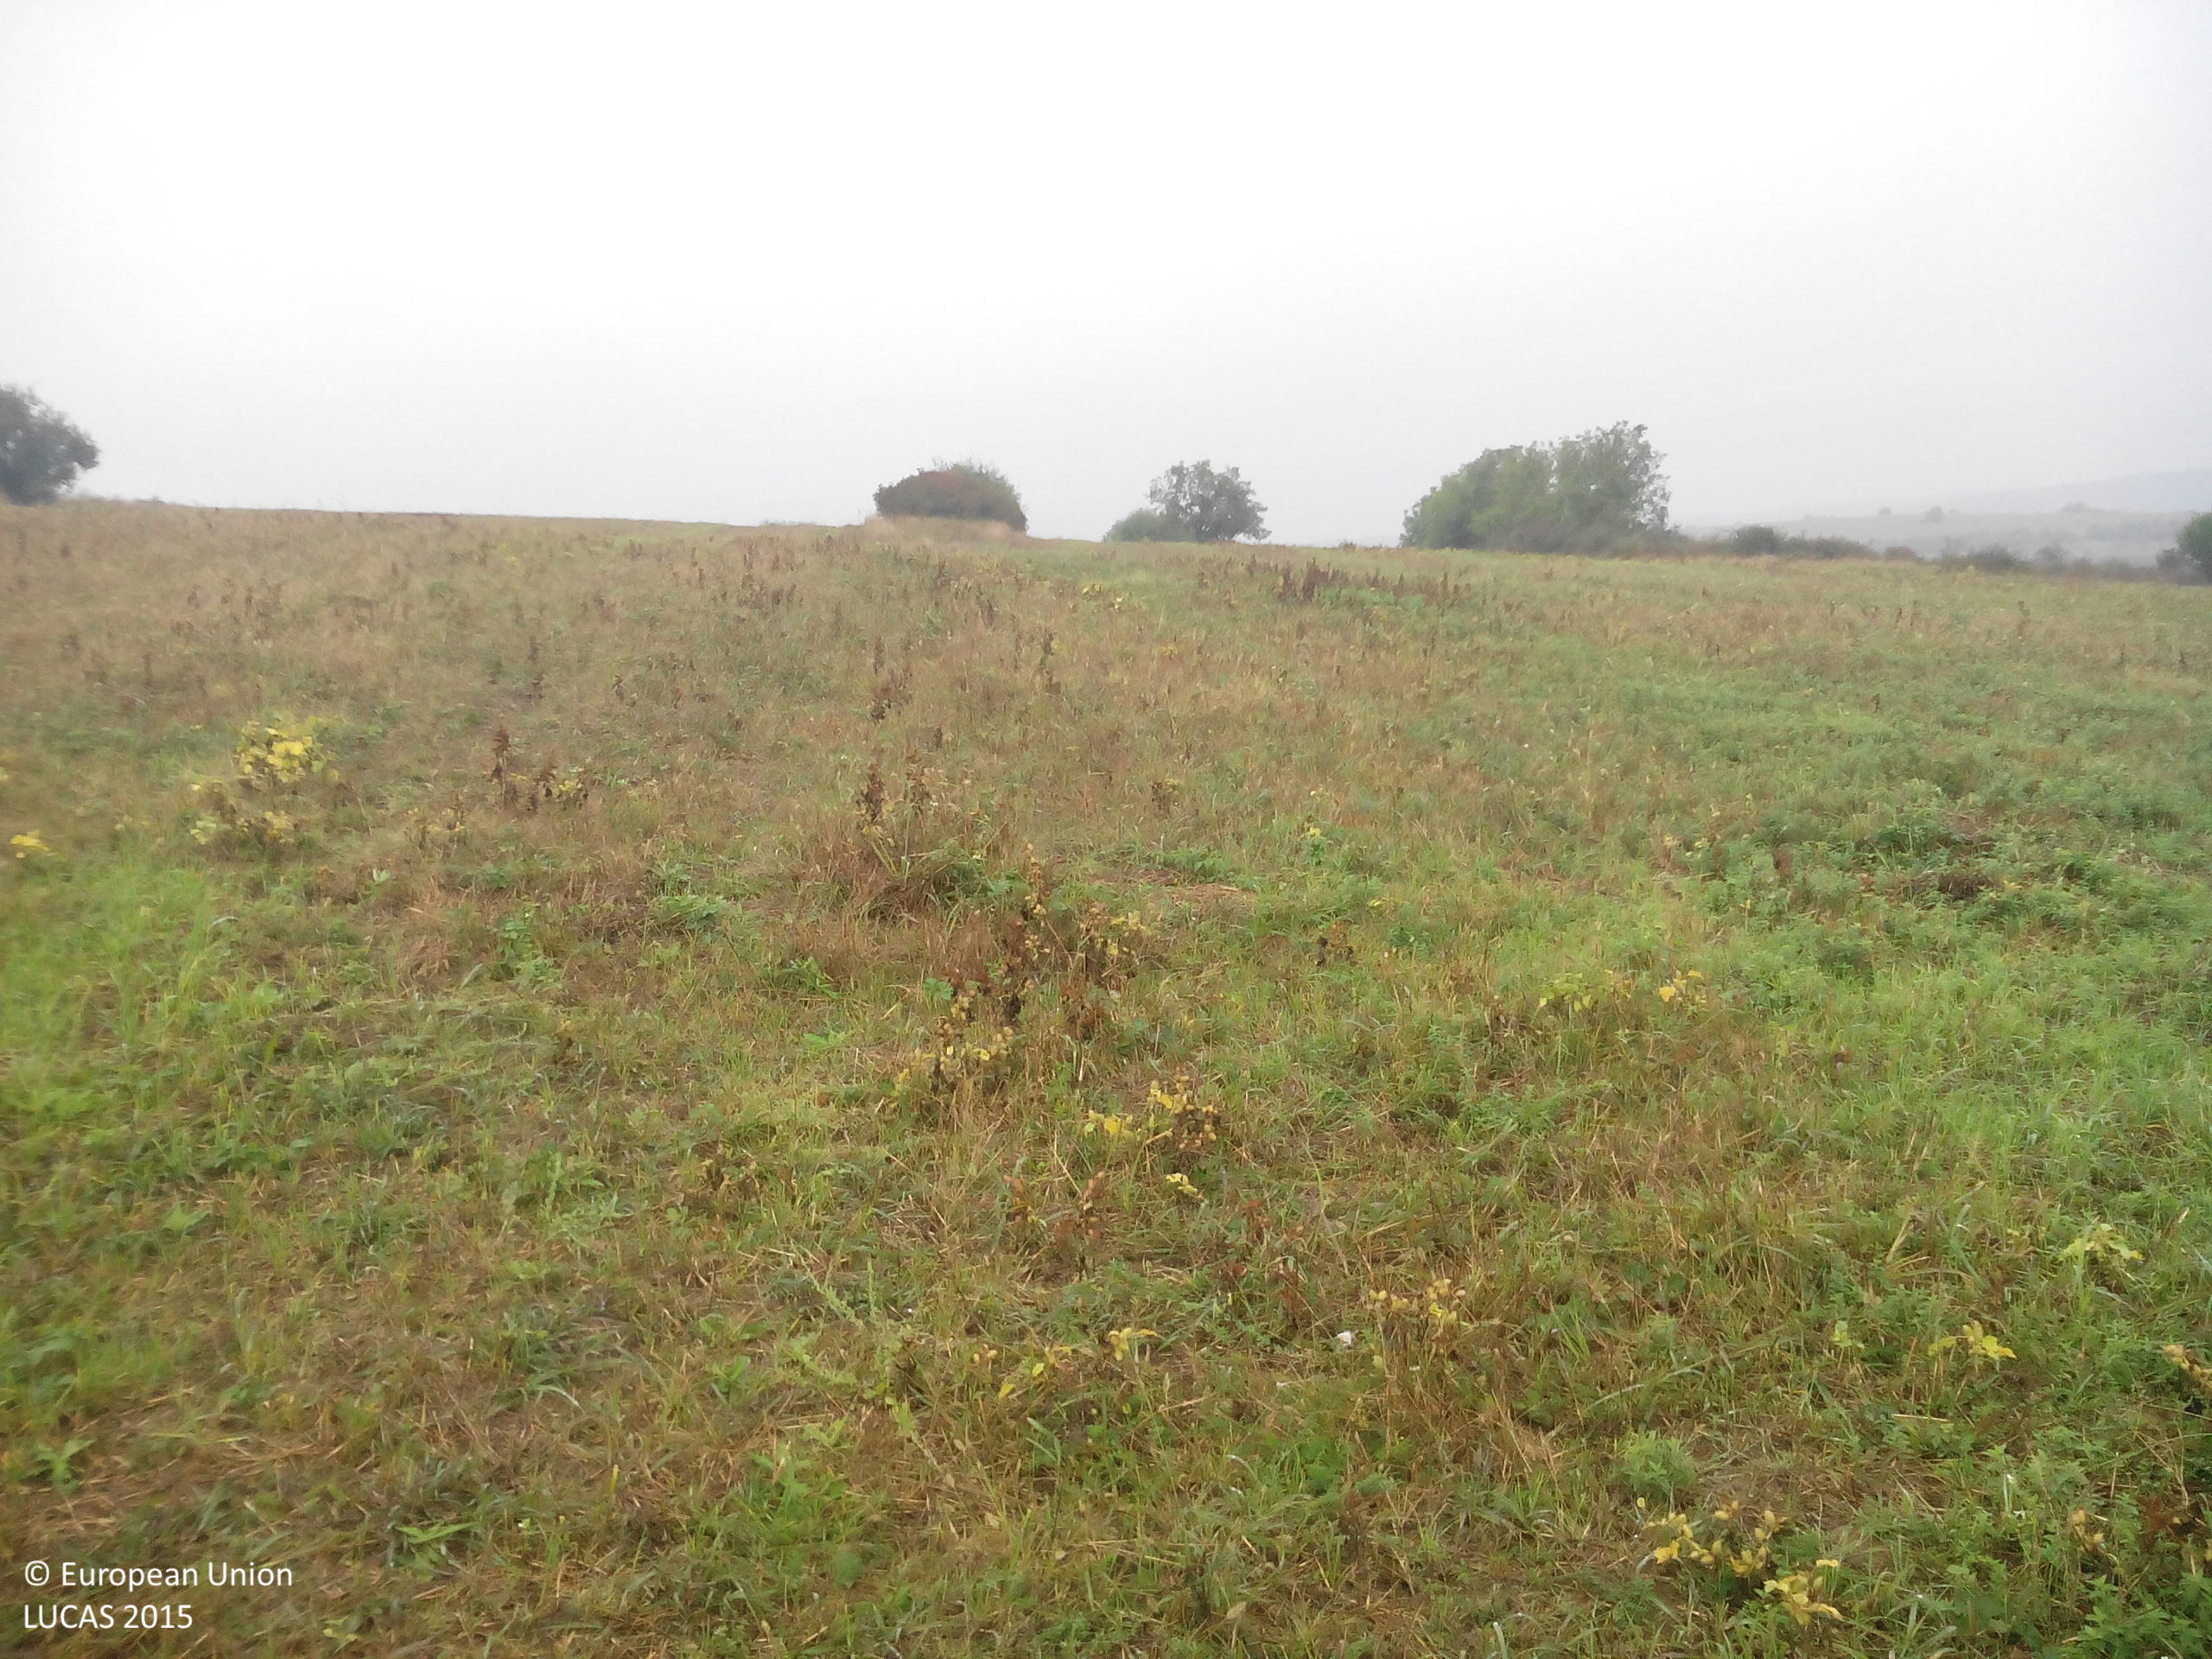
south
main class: Grassland
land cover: Grassland without tree/shrub cover
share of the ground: > 75 %
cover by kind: herbaceous plants 95 %, shrubs 5 %
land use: Agriculture (excluding fallow land and kitchen gardens)
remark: Harvested field
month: October
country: BG
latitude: 43.1724
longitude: 24.1617
